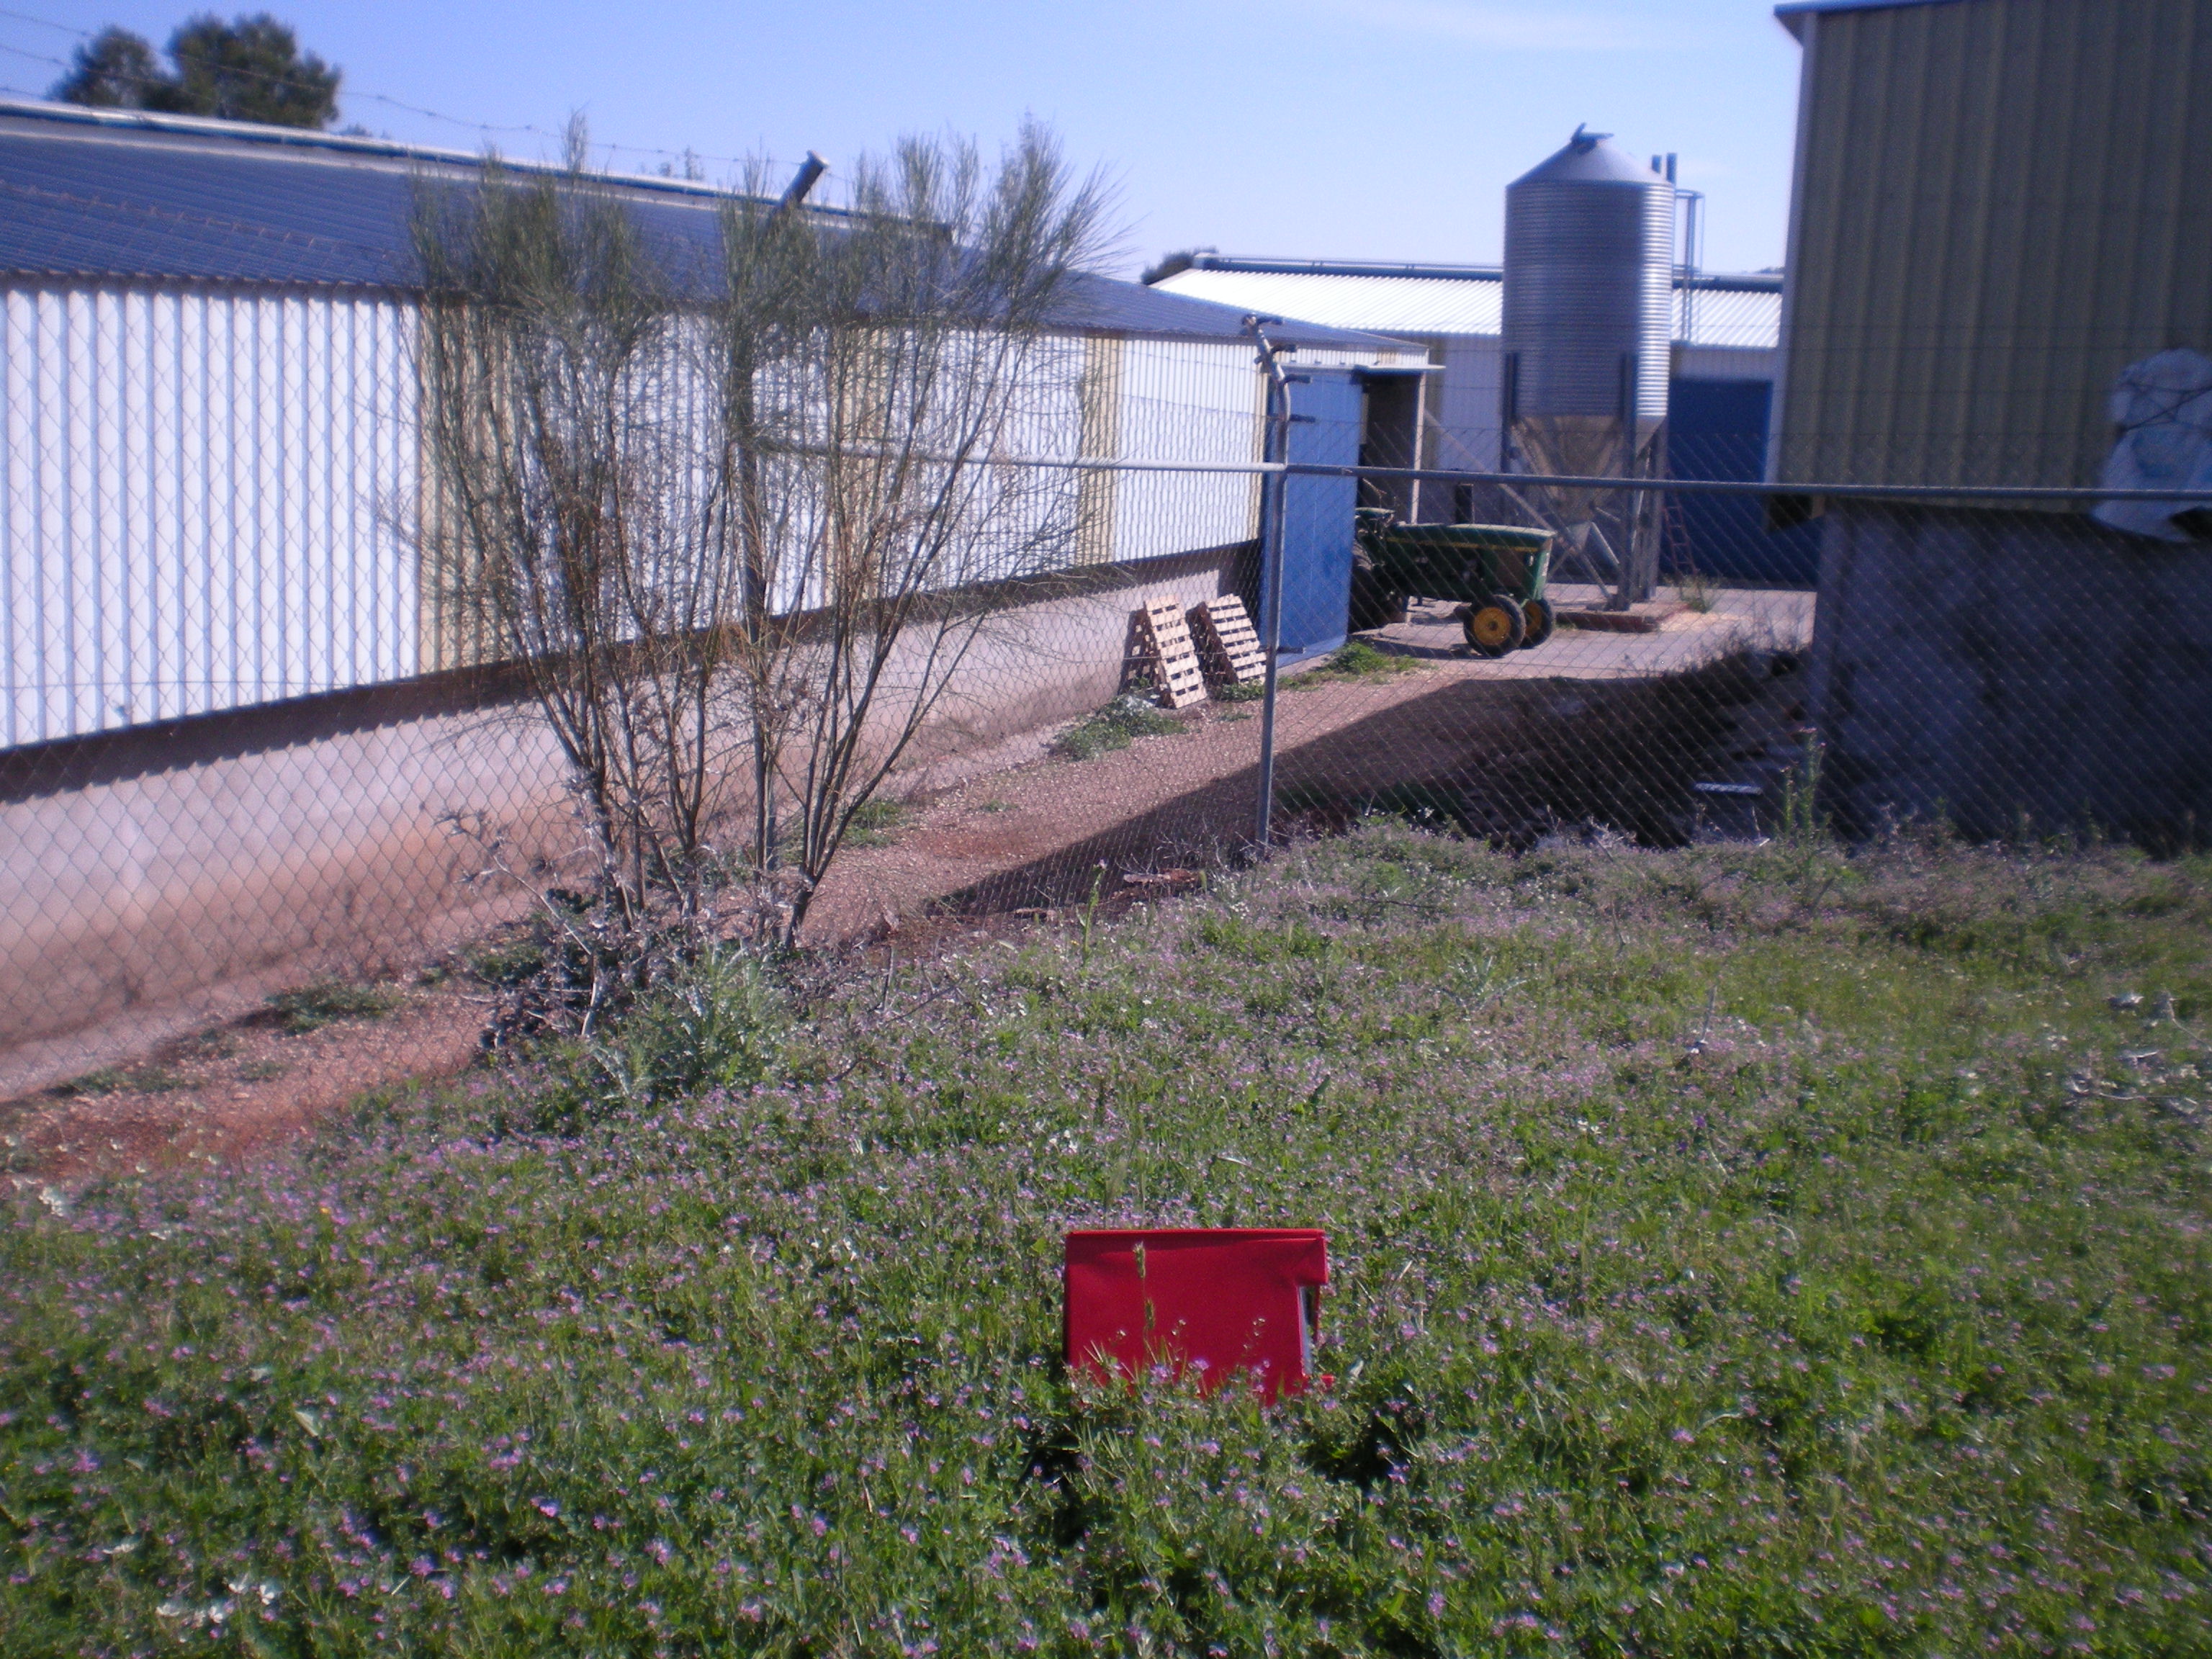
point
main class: Grassland
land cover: Grassland without tree/shrub cover
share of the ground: > 75 %
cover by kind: herbaceous plants 80 %, unconsolidated bare surface 20 %
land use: Agriculture (excluding fallow land and kitchen gardens)
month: April
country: ES
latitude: 38.9170
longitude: -3.5668
